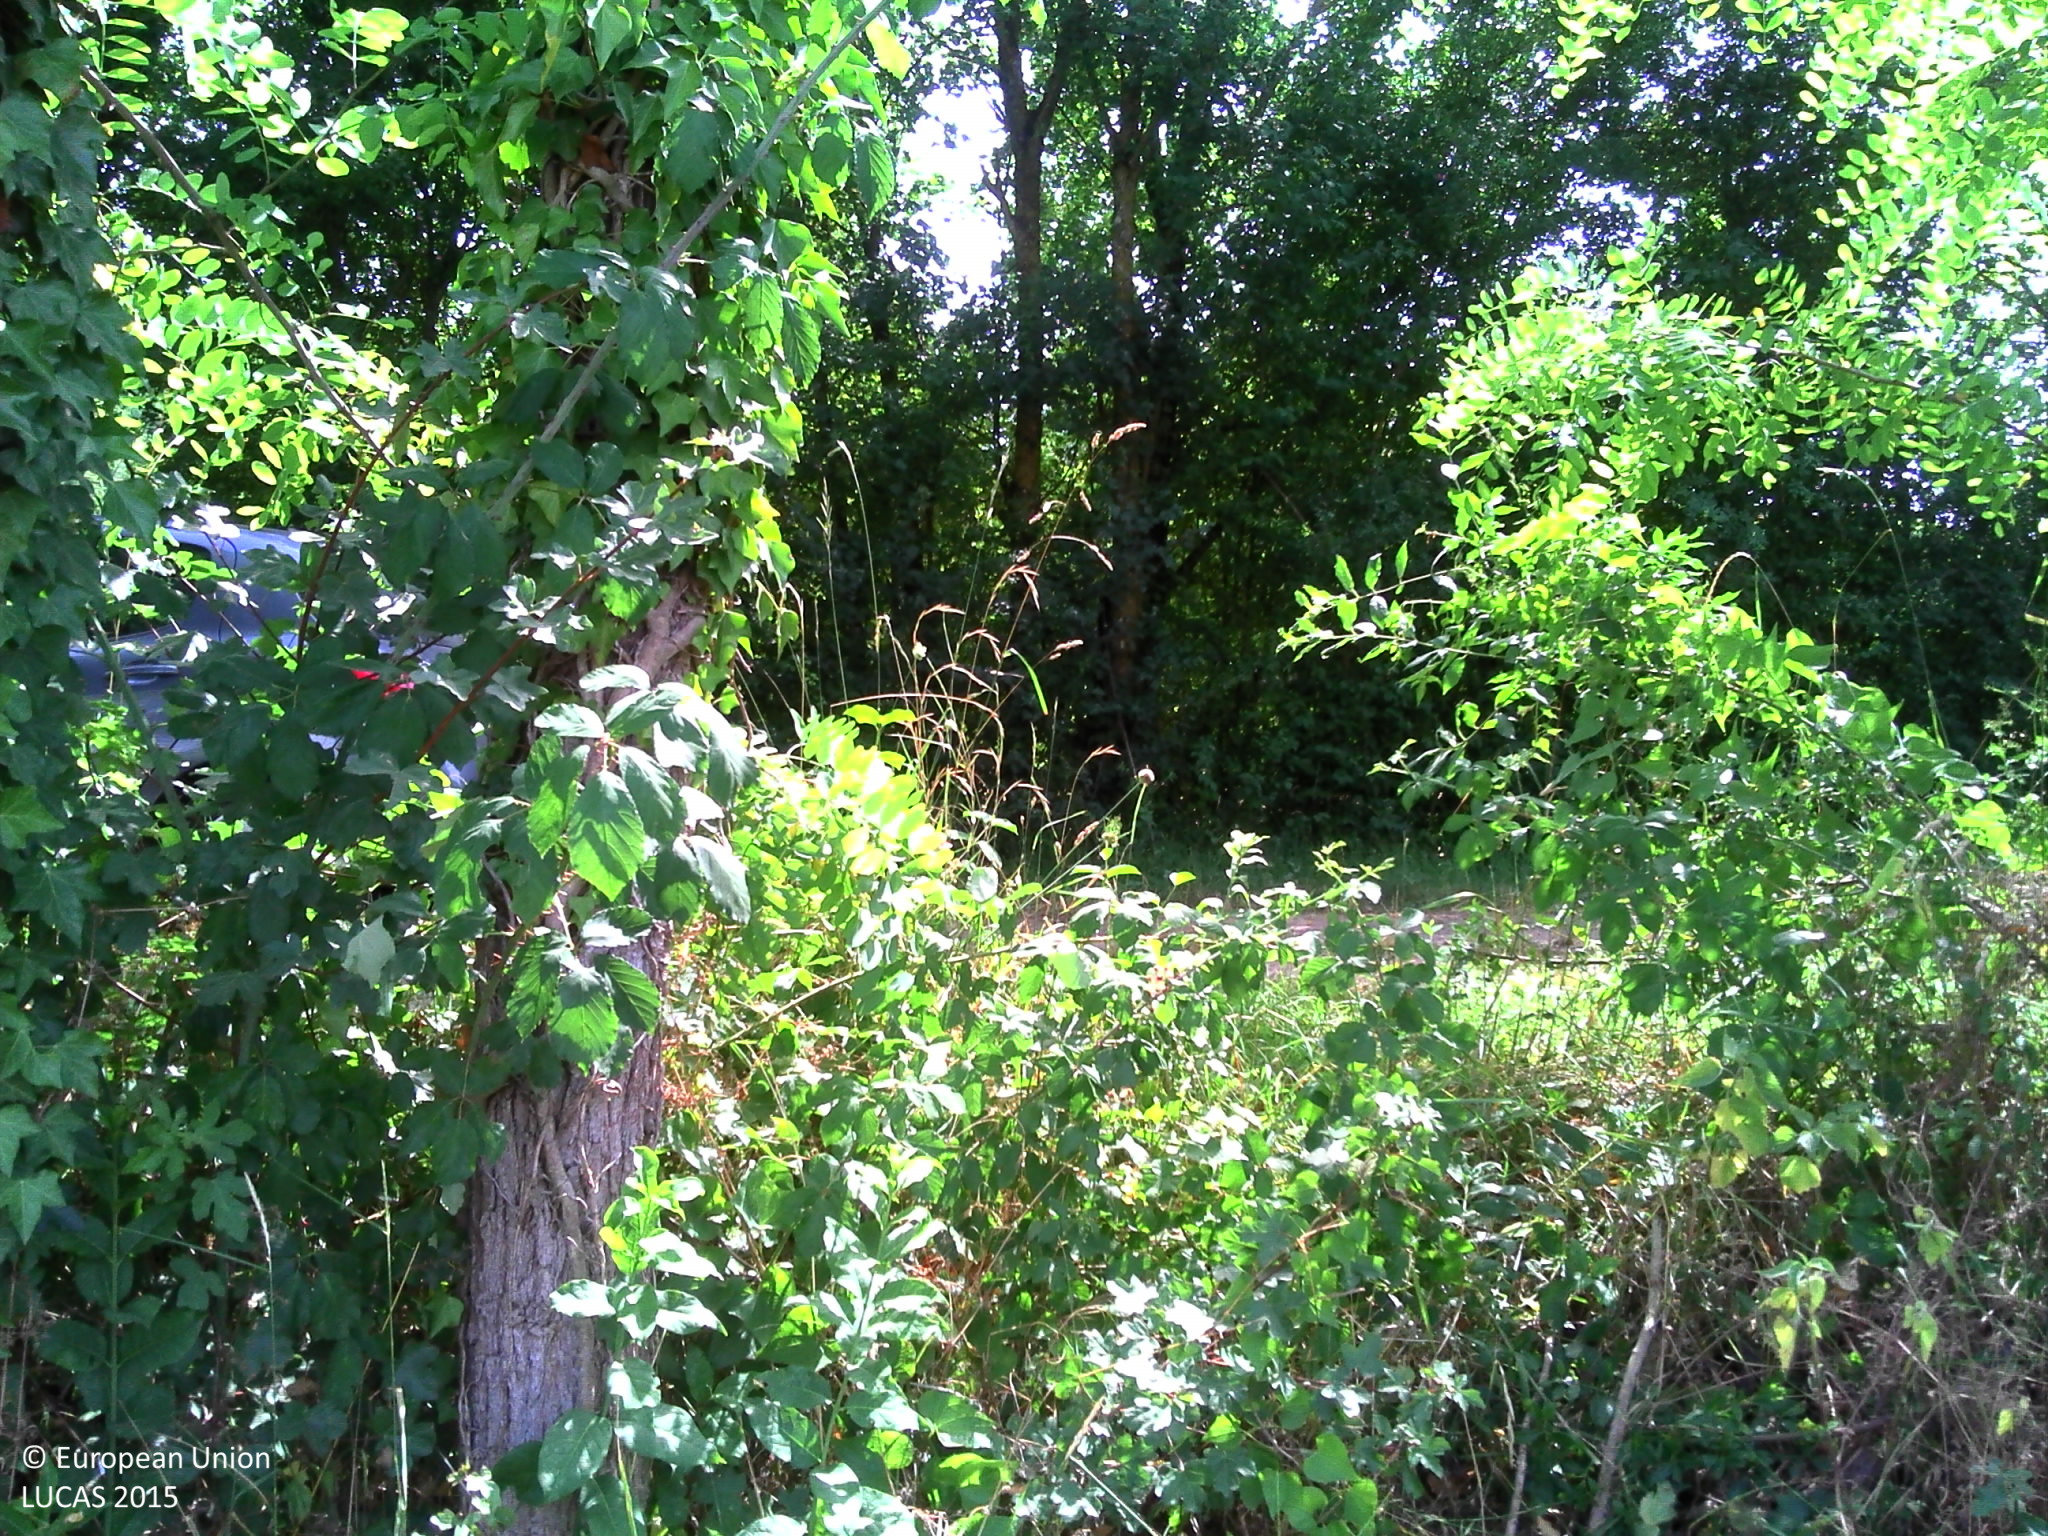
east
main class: Cropland
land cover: Rape and turnip rape
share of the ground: > 75 %
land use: Agriculture (excluding fallow land and kitchen gardens)
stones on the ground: < 10 %
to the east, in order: Rape and turnip rape; Lines of trees; Grass margins; Tracks; Grass margins; Ditches and canals; Lines of trees; Managed hedges; Grassland without tree/shrub cover; Broadleaved woodland
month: July
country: FR
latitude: 47.3291
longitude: 3.5261
